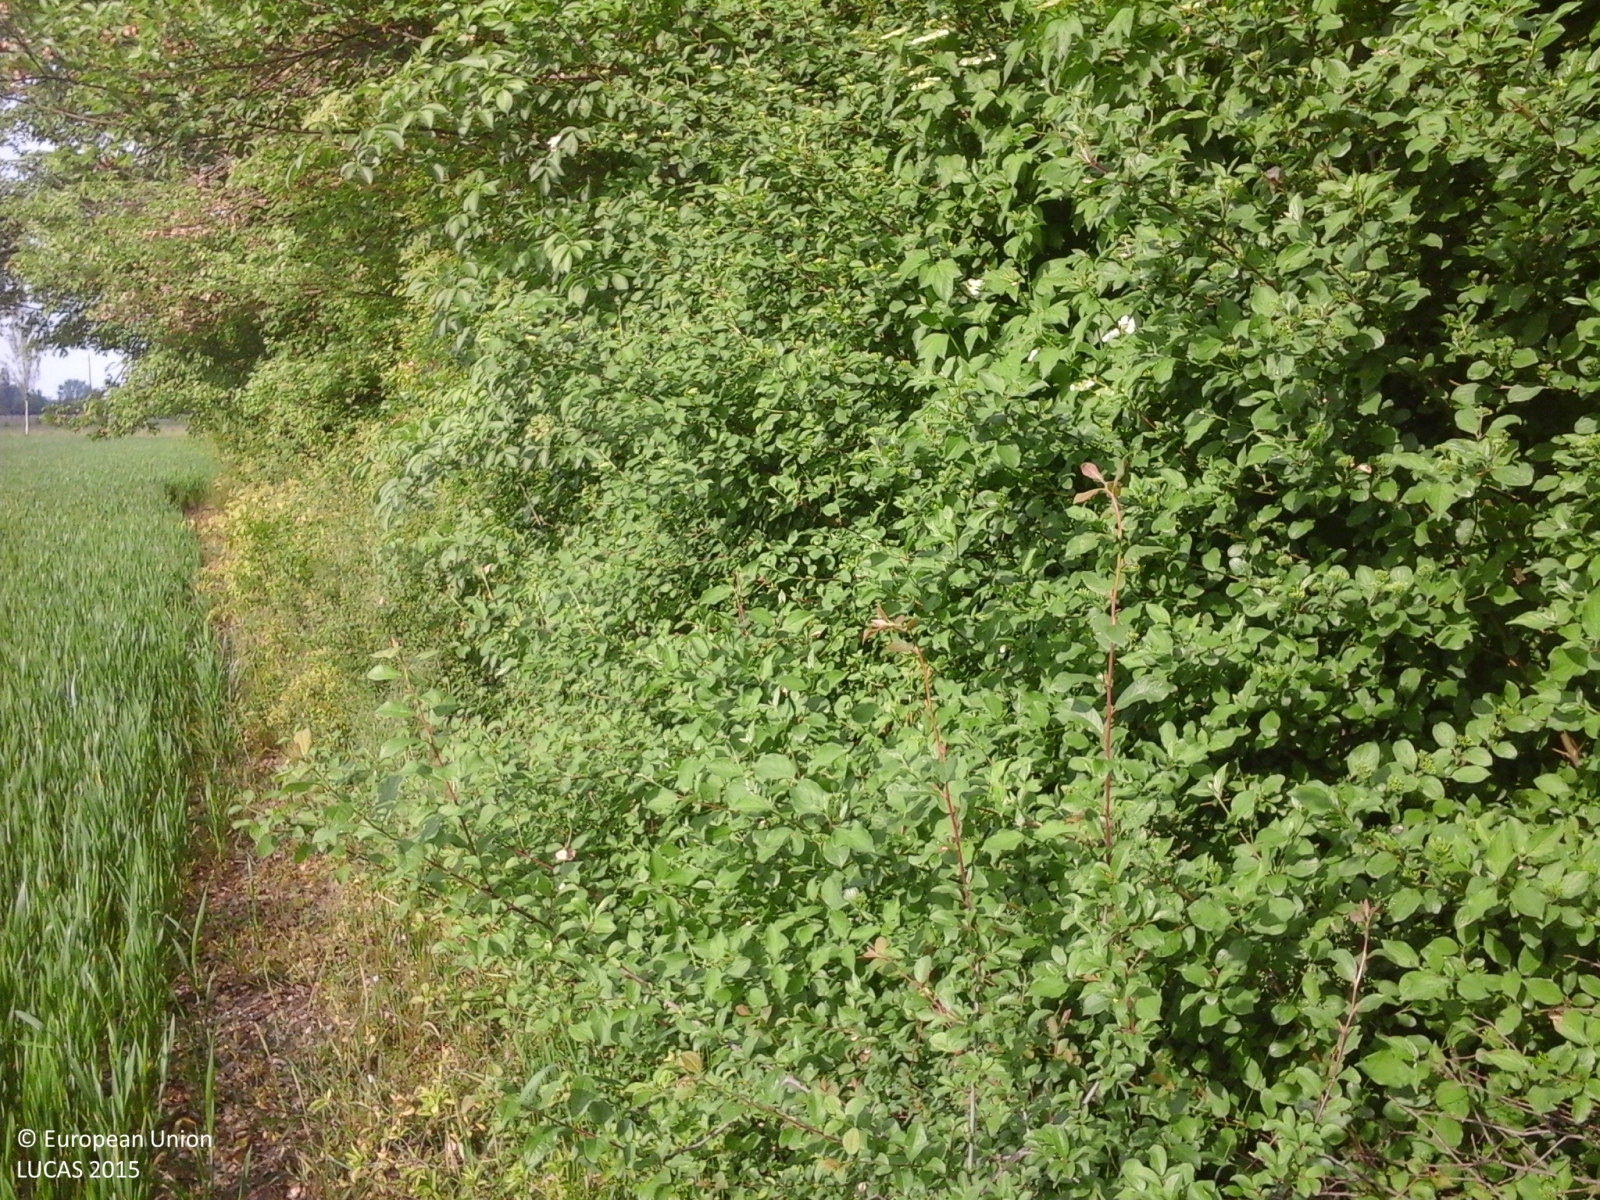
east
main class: Cropland
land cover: Common wheat
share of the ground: > 75 %
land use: Agriculture (excluding fallow land and kitchen gardens)
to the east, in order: Managed hedges; Broadleaved woodland; Paved roads, cycling and walking lanes; Broadleaved woodland; Artificial constructions in urban areas; Broadleaved woodland
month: April
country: IT
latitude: 44.7256
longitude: 10.8694
